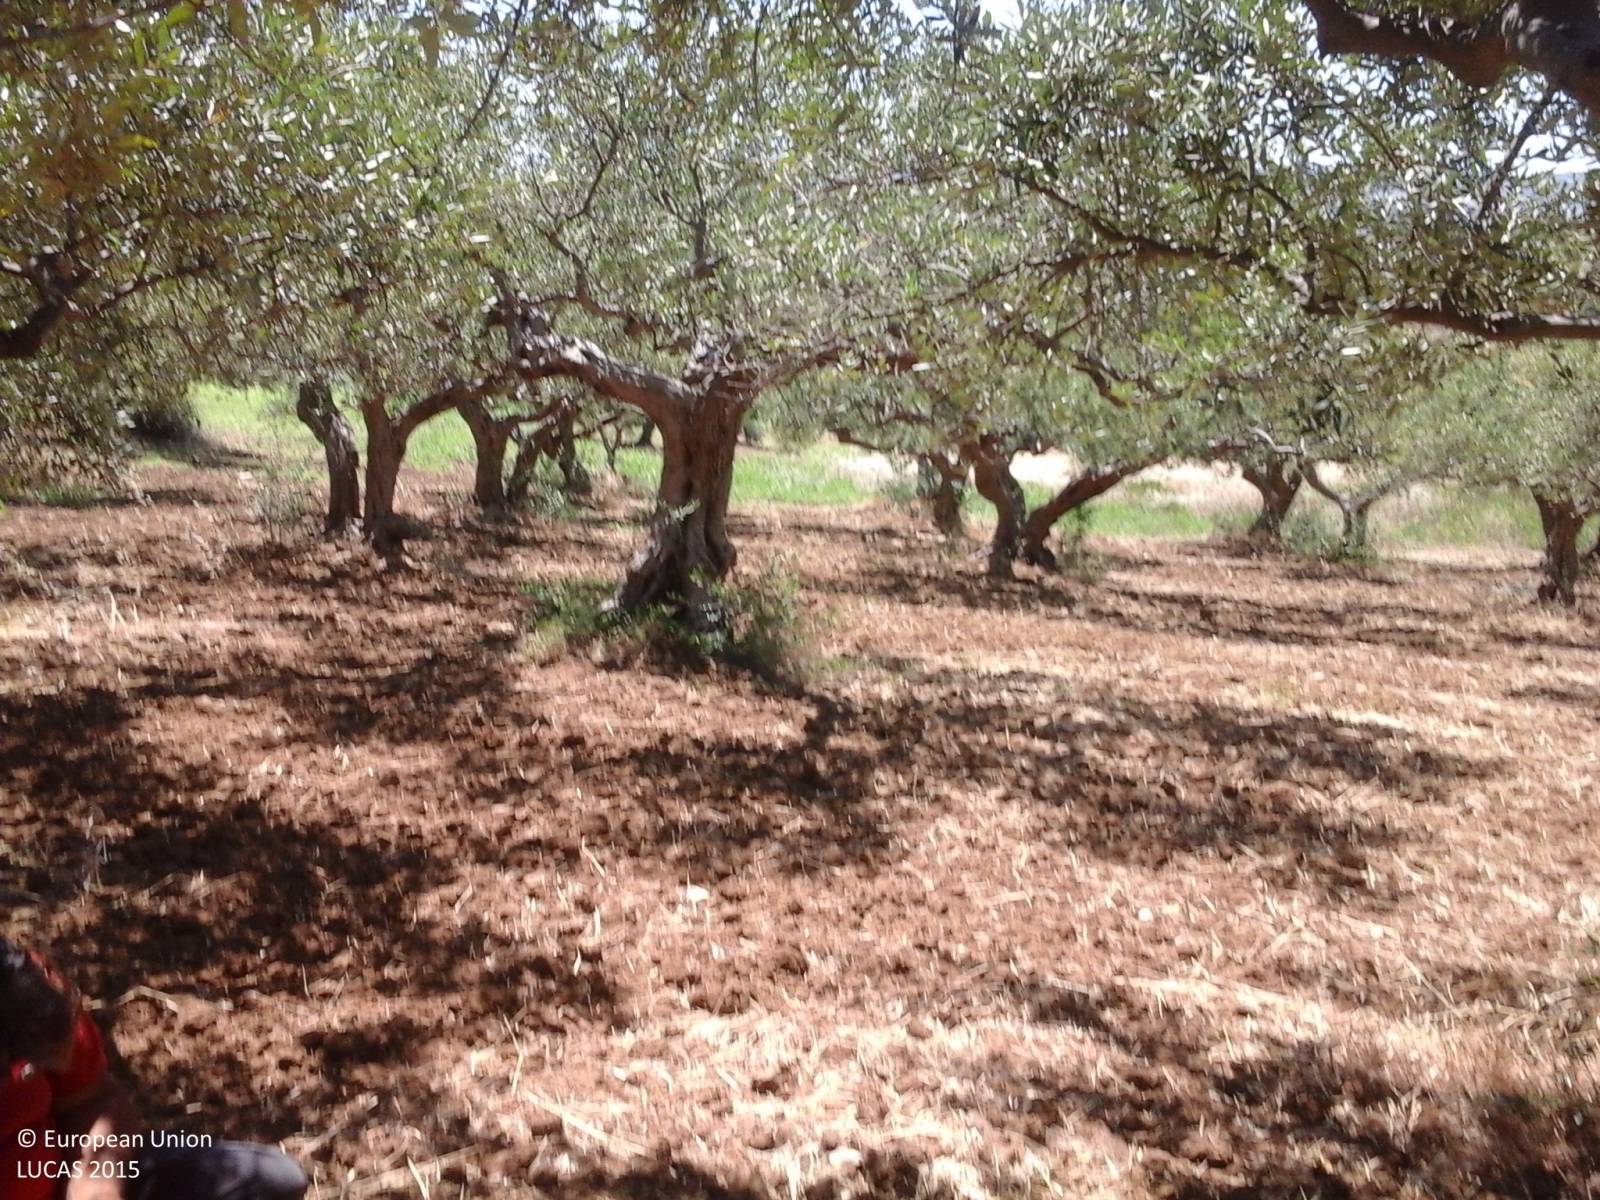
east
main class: Cropland
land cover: Olive groves
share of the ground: 50 - 75 %
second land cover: Other bare soil
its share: > 75 %
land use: Agriculture (excluding fallow land and kitchen gardens)
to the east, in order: Olive groves; Other bare soil; Grassland without tree/shrub cover; Olive groves; Grassland without tree/shrub cover; Shruby margins; Paved roads, cycling and walking lanes; Lines of trees
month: June
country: IT
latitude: 37.8500
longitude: 12.8543
